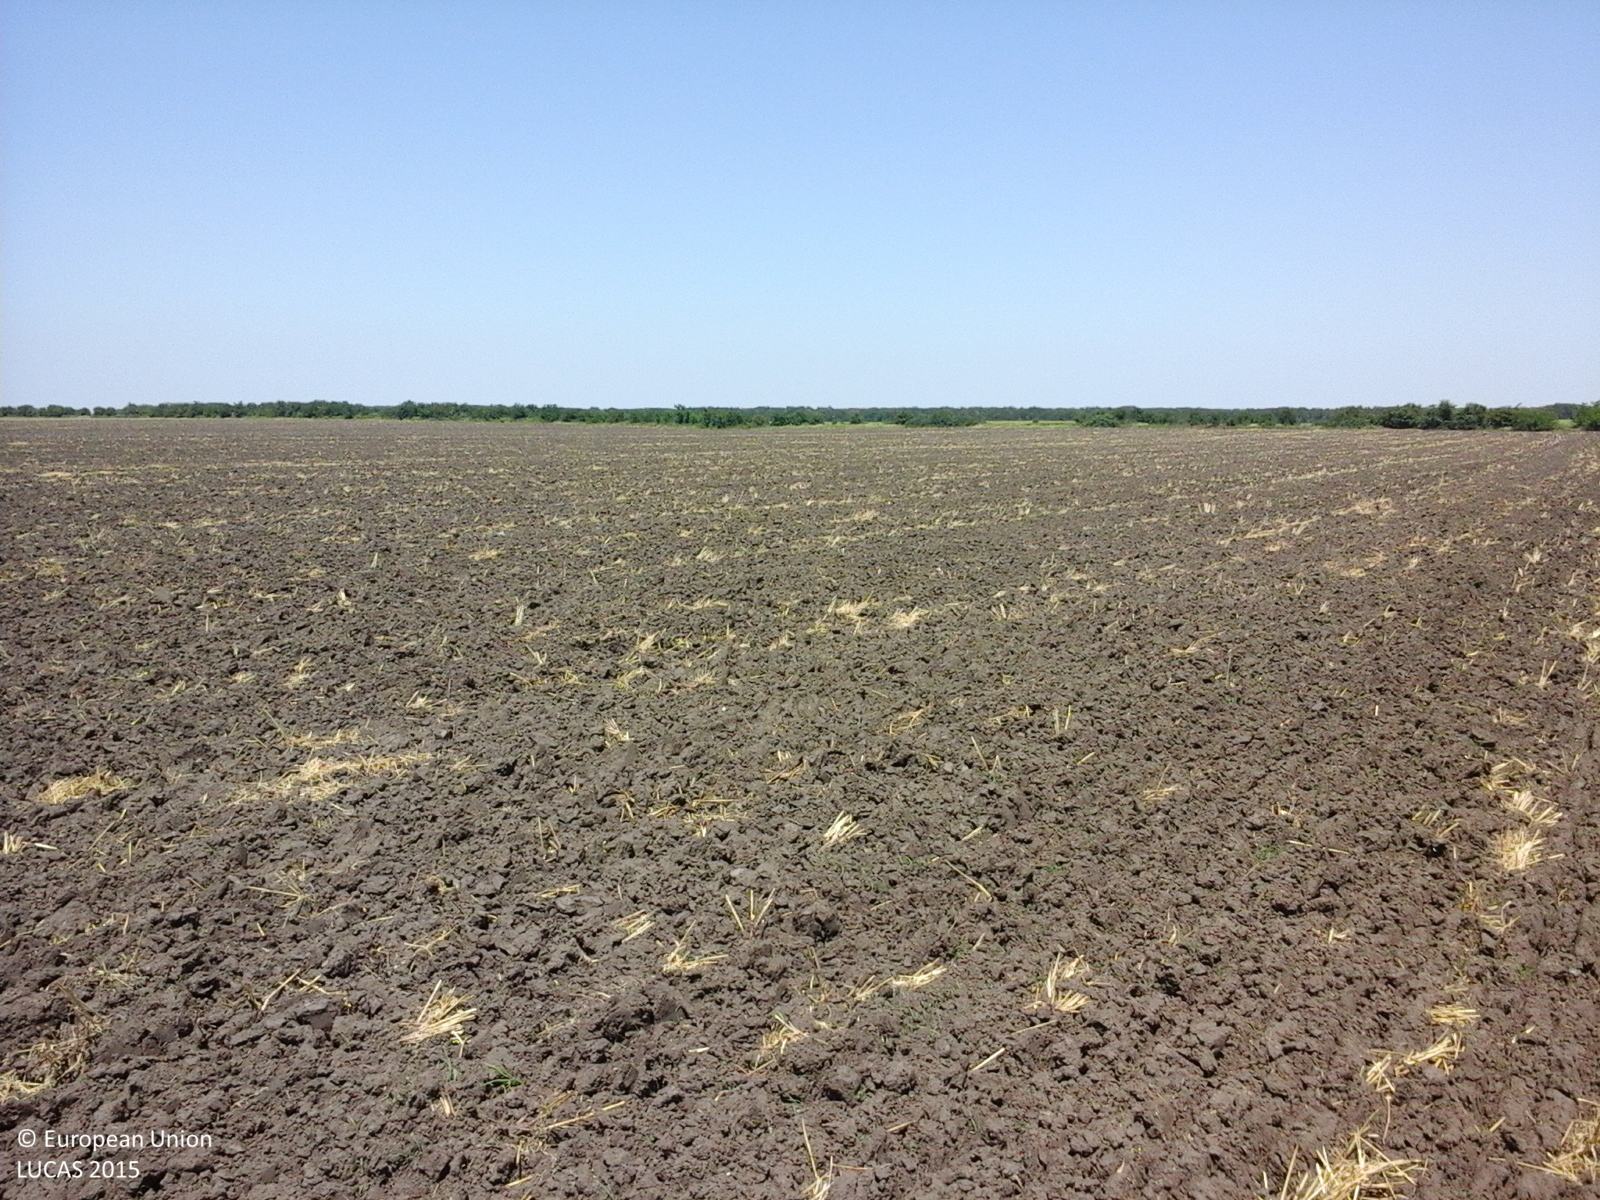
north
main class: Cropland
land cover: Common wheat
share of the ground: < 10 %
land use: Agriculture (excluding fallow land and kitchen gardens)
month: July
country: RO
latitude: 44.2817
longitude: 26.6446
